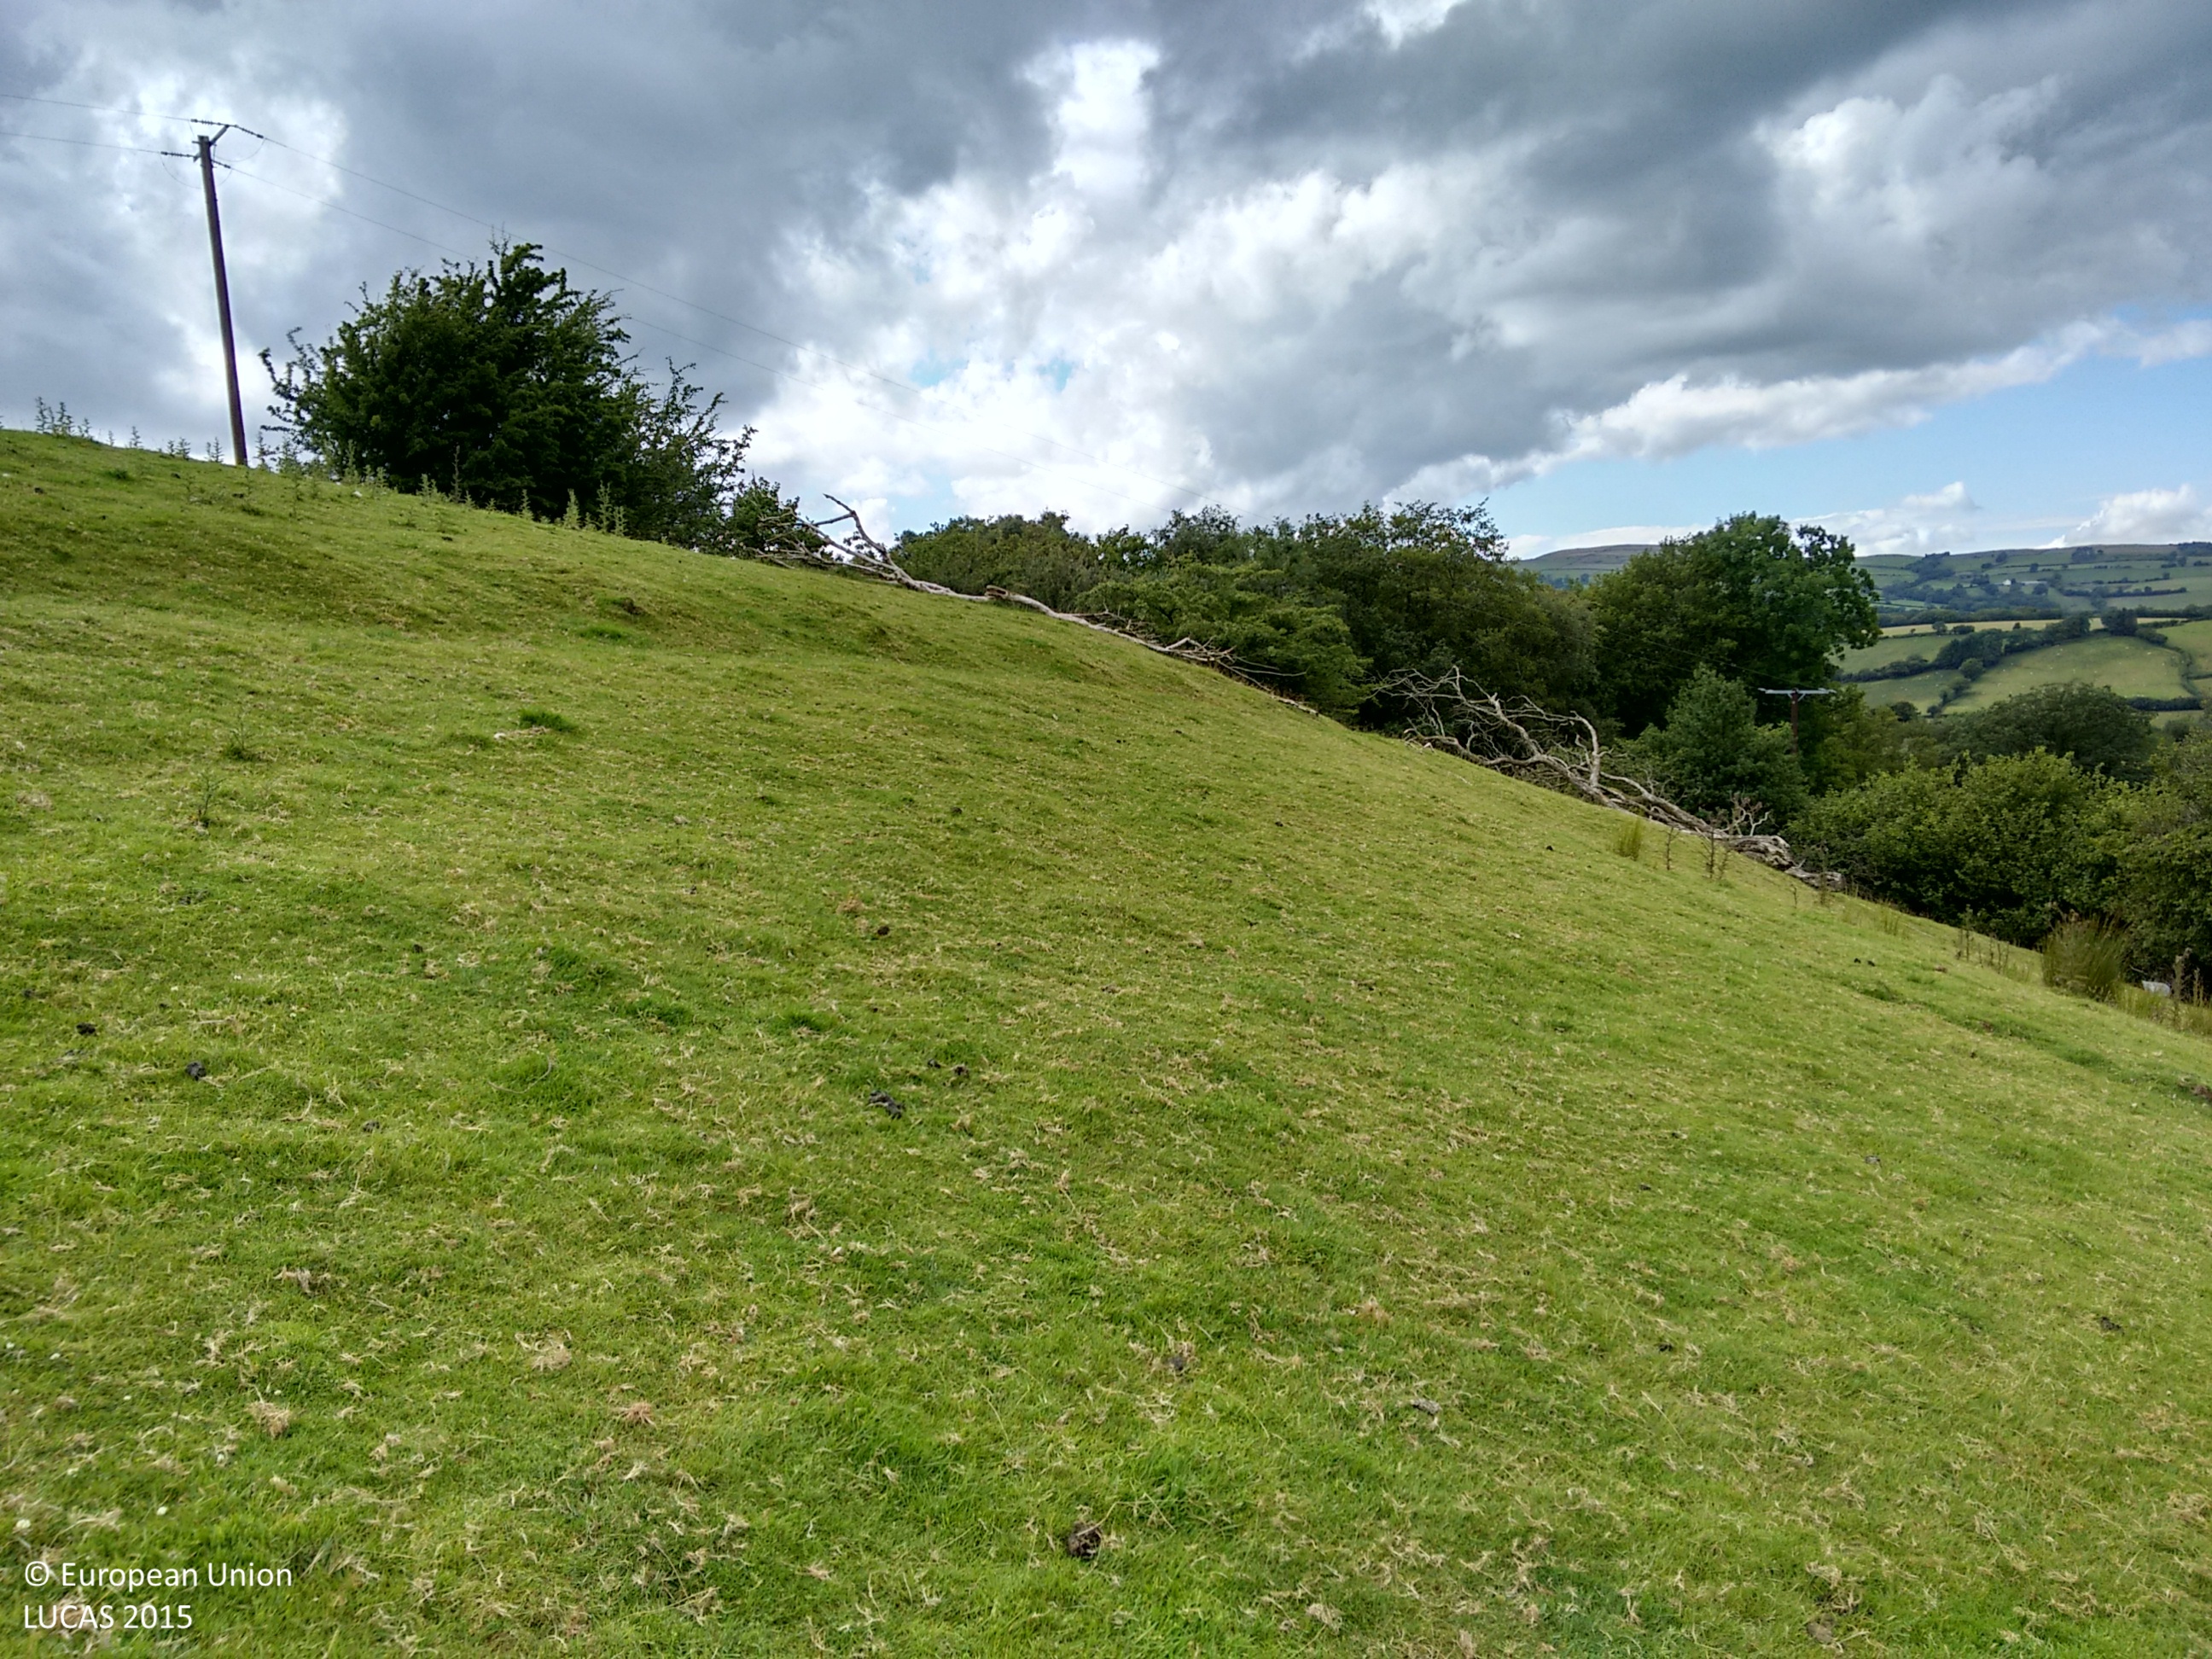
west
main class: Grassland
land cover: Grassland without tree/shrub cover
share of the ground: > 75 %
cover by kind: herbaceous plants 100 %
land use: Agriculture (excluding fallow land and kitchen gardens)
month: July
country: GB
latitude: 51.8712
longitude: -3.8457
